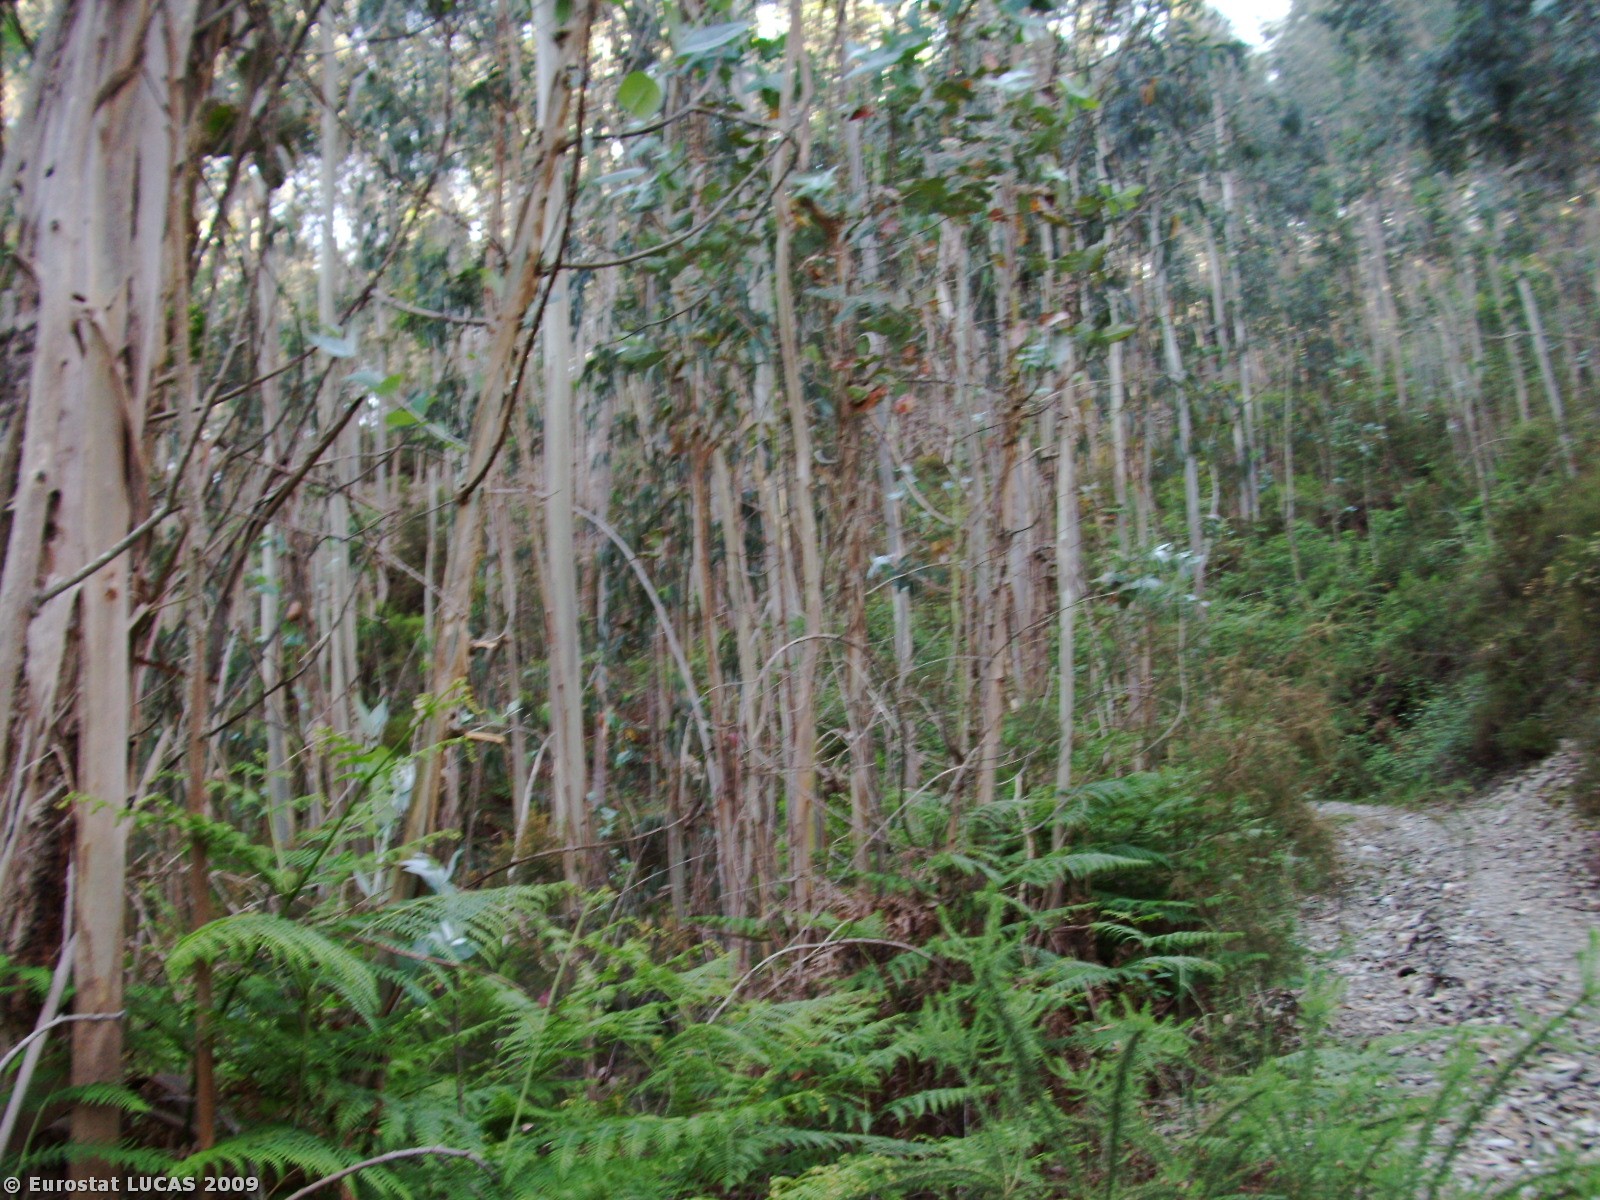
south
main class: Woodland
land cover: Broadleaved woodland
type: plantations and self-sown exotic forest
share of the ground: > 75 %
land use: Forestry
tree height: > 5 m
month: May
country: PT
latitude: 40.5834
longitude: -8.3895
